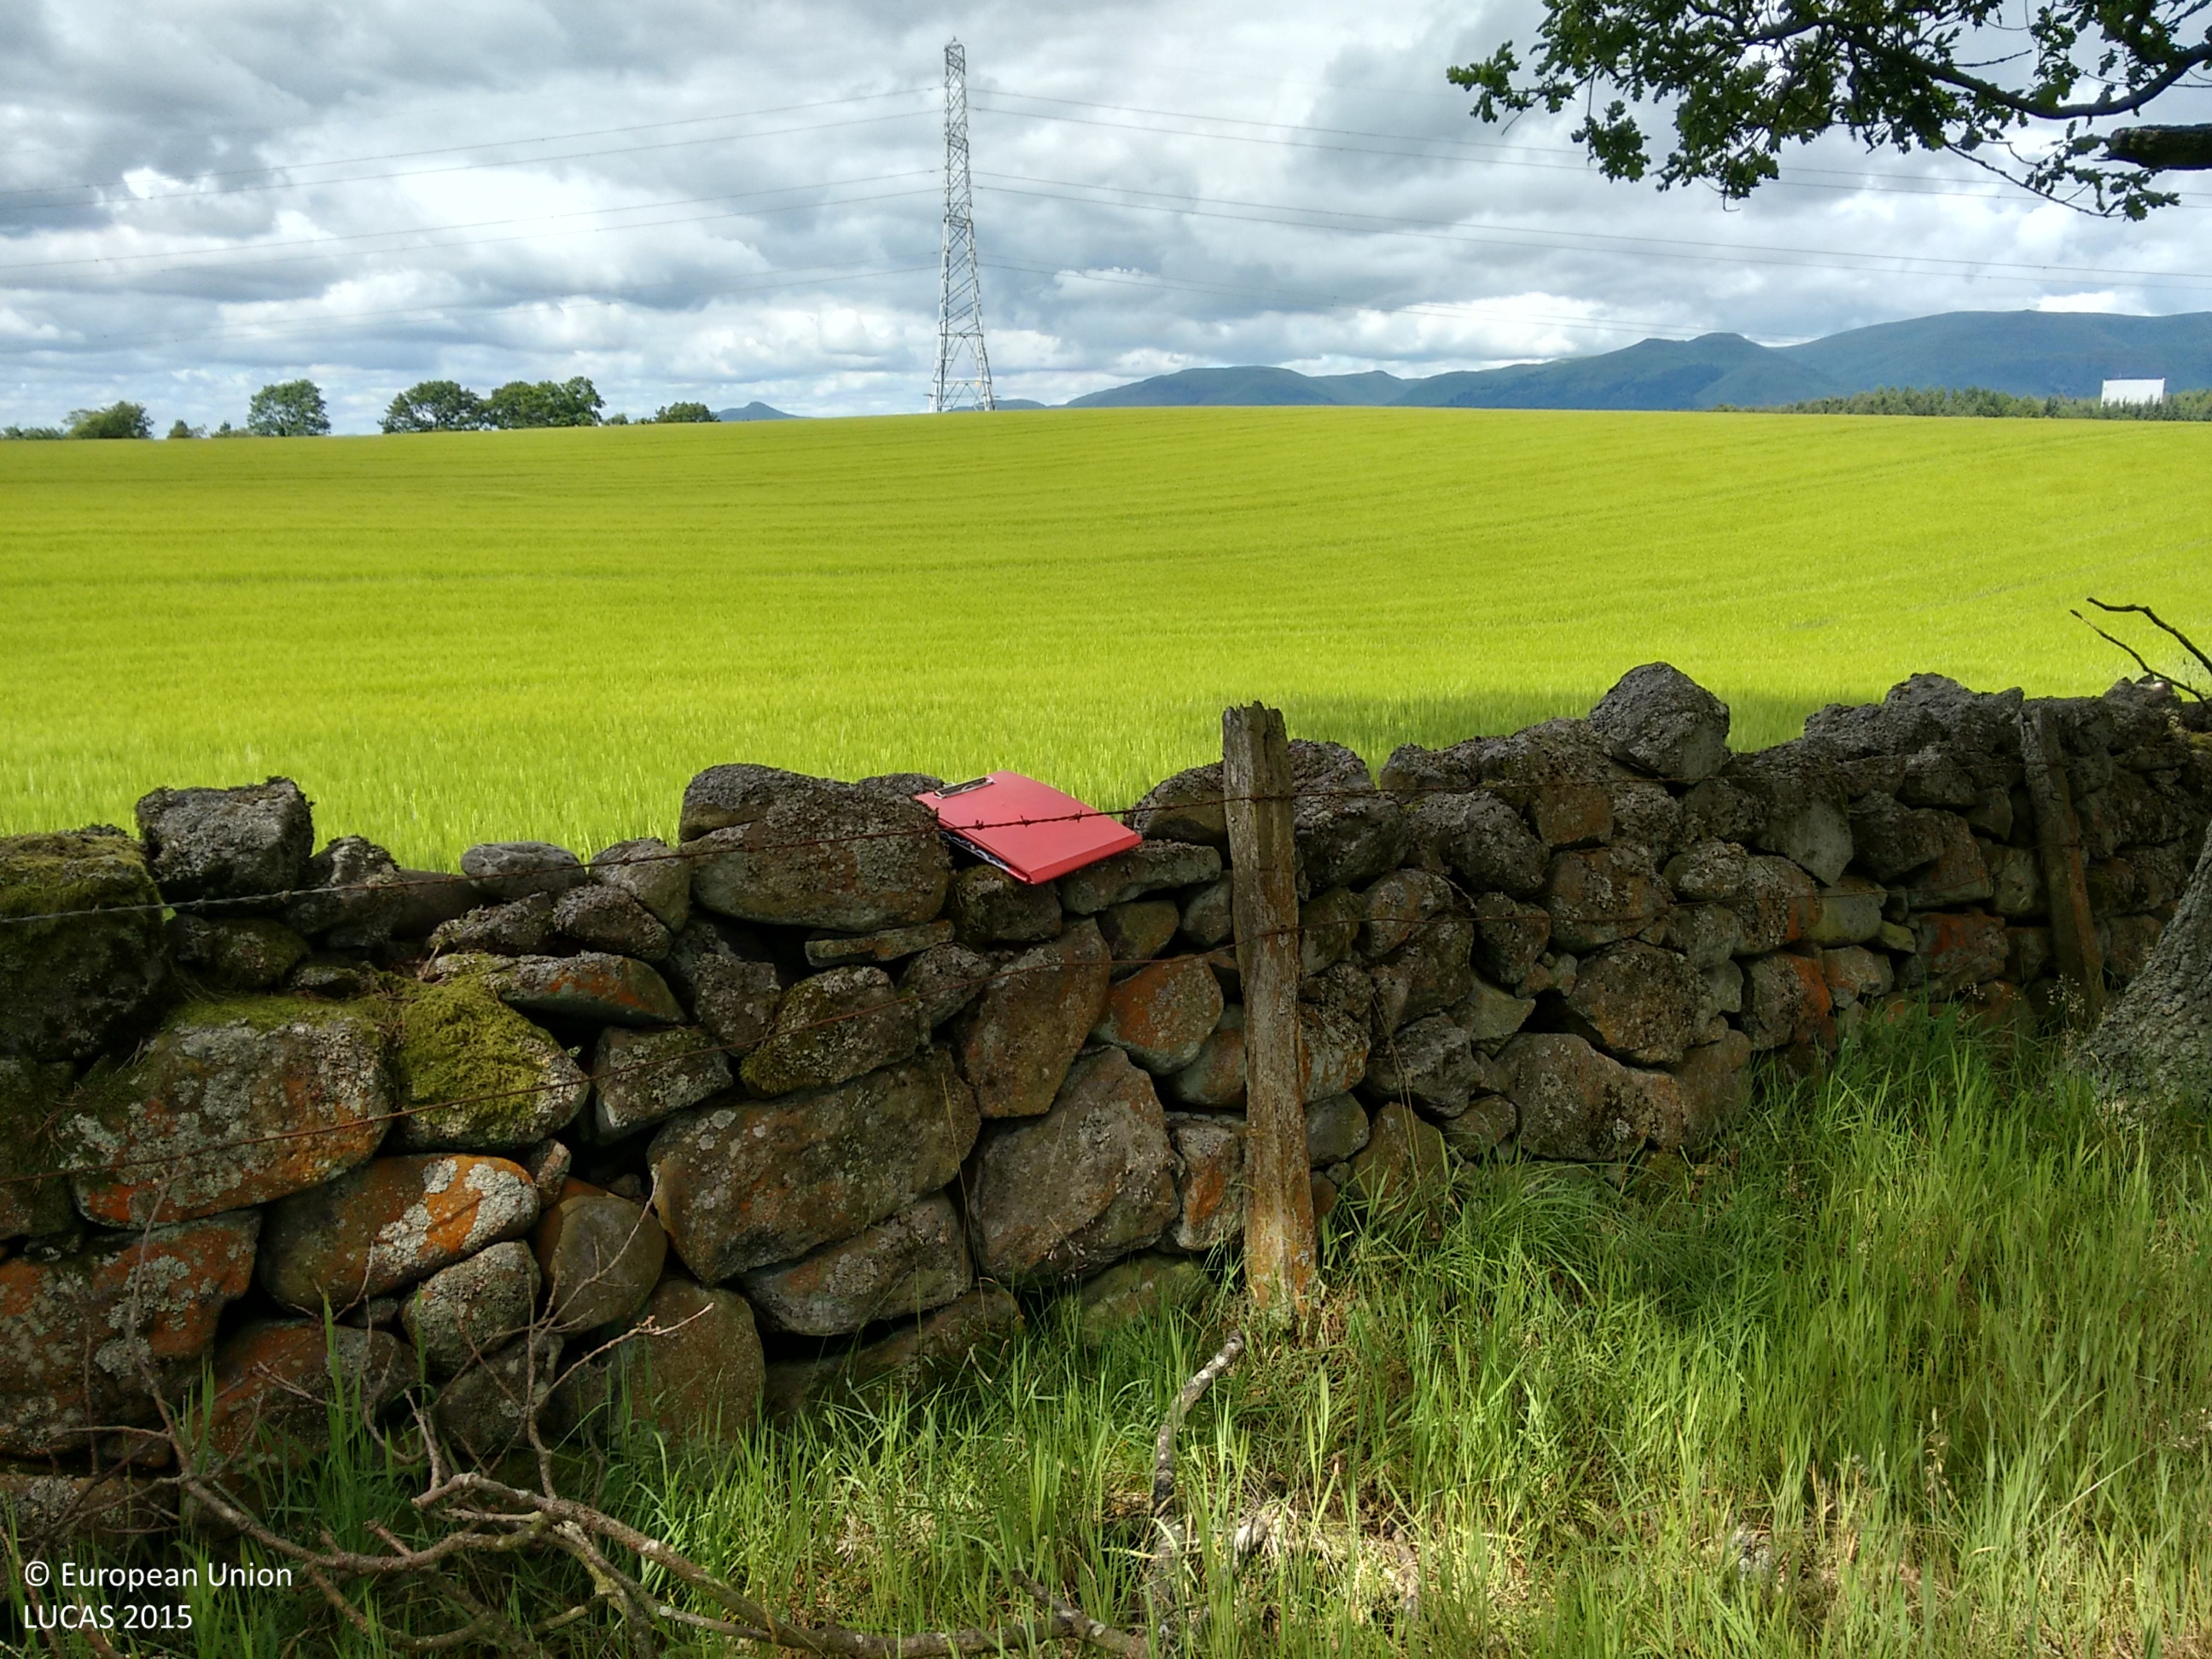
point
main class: Woodland
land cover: Pine dominated mixed woodland
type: exotic forest
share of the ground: > 75 %
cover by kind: coniferous forest trees 65 %, broadleaved forest trees 25 %, herbaceous plants 10 %
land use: Agriculture (excluding fallow land and kitchen gardens)
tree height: > 5 m
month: July
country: GB
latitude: 56.1060
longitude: -3.6994
